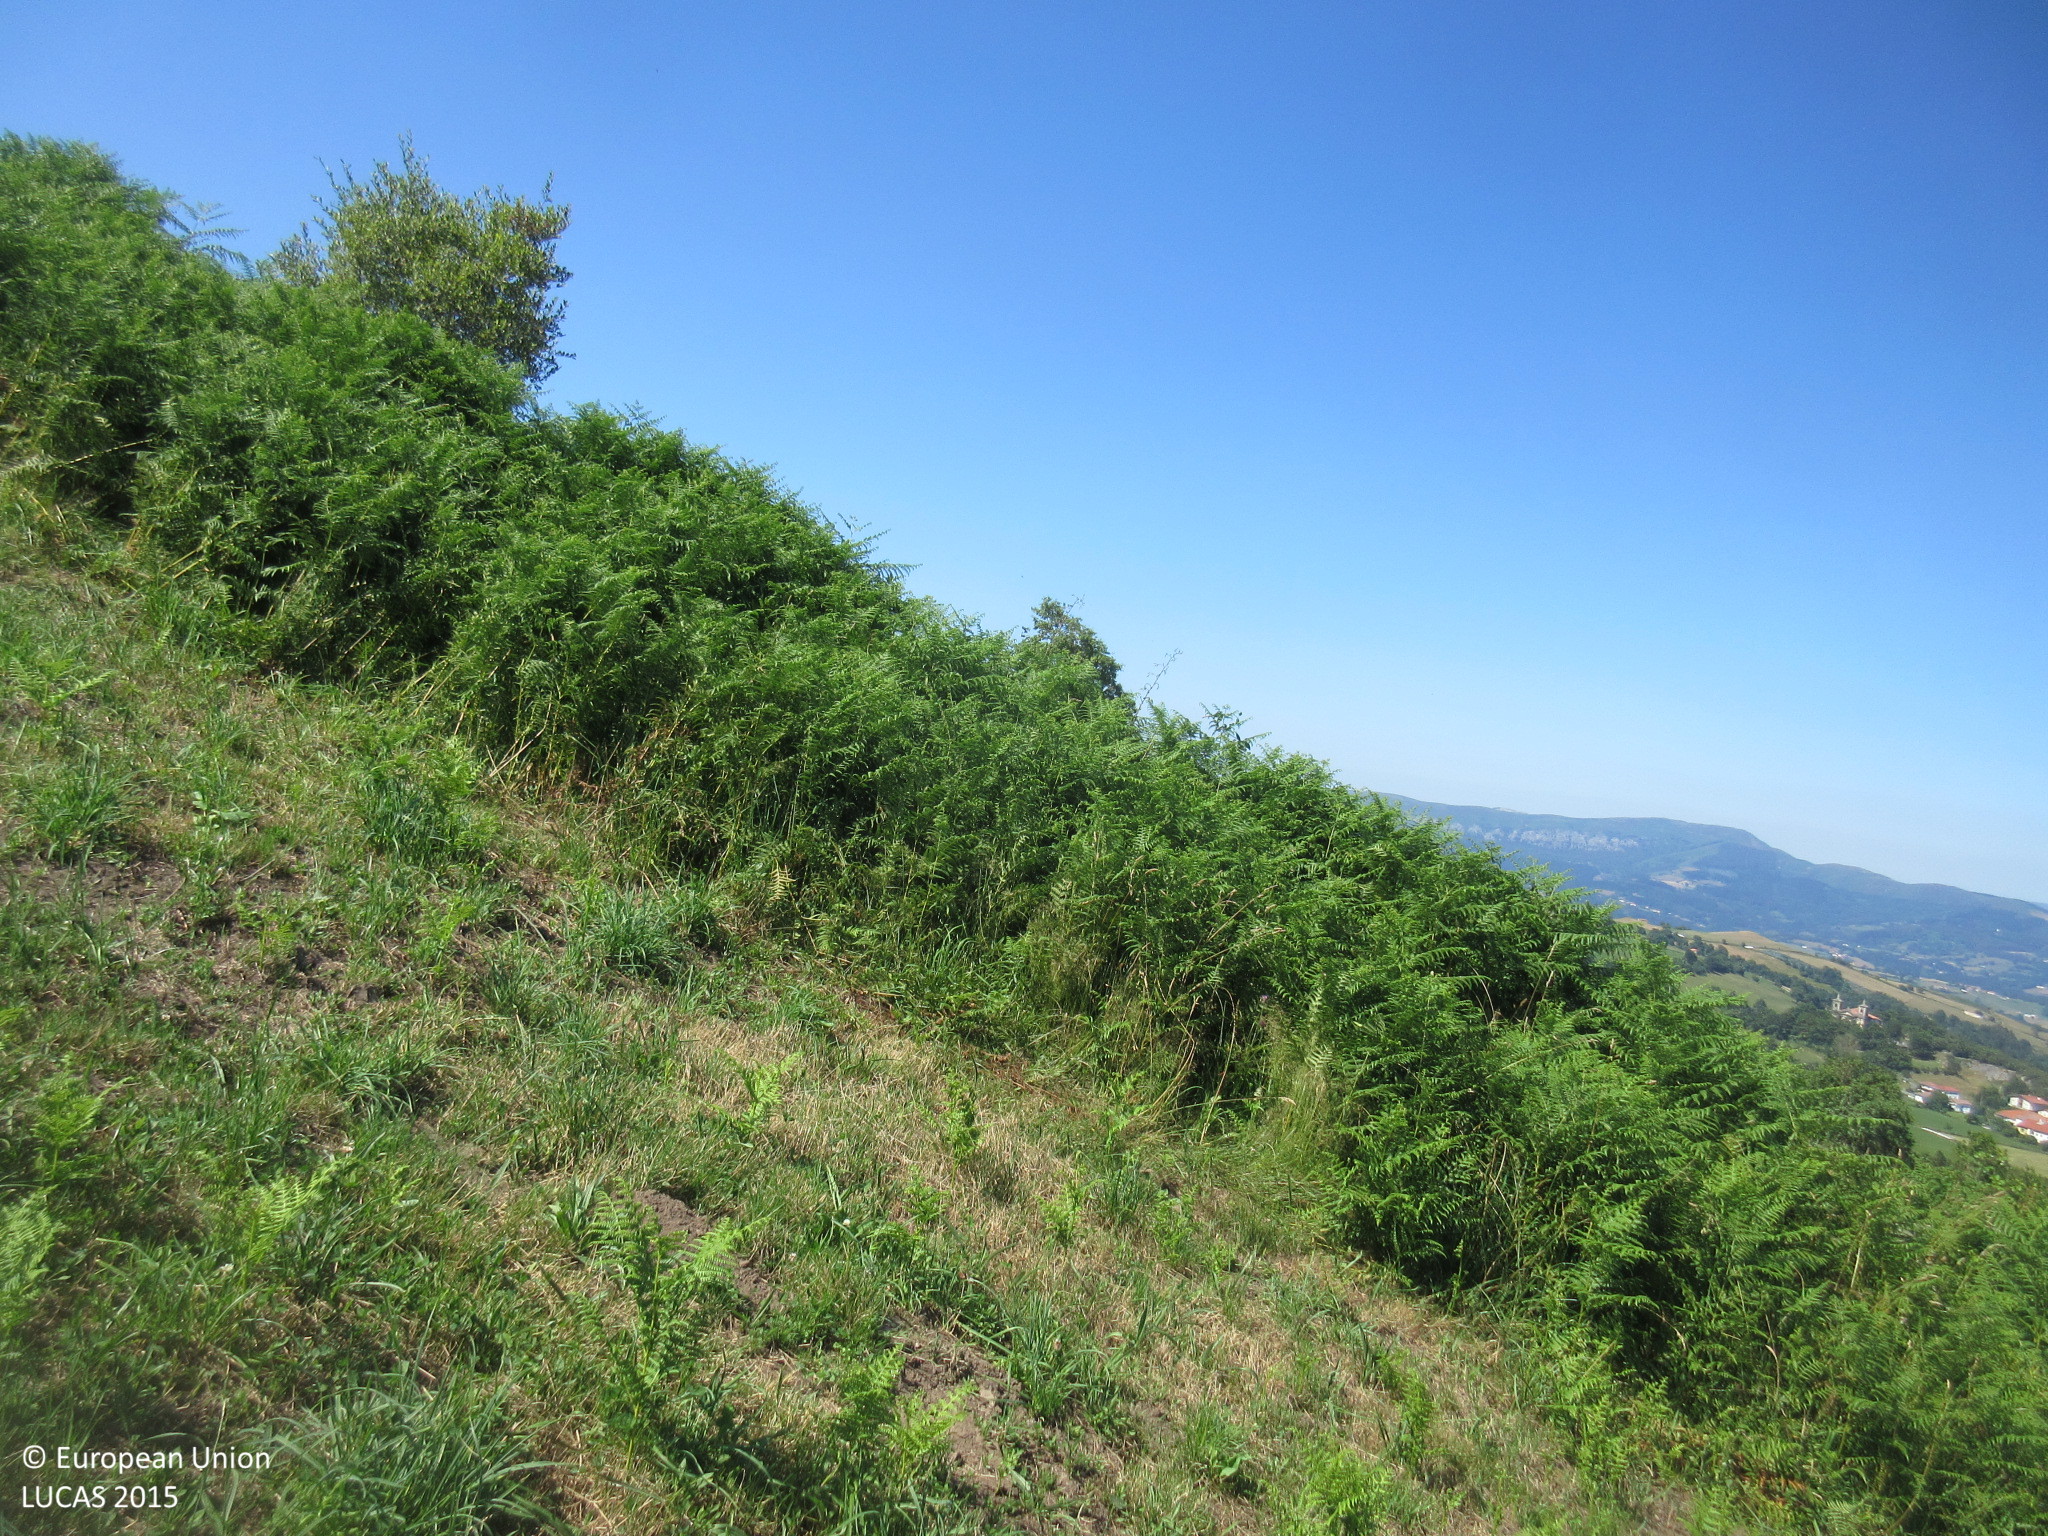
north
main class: Grassland
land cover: Grassland without tree/shrub cover
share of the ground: > 75 %
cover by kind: herbaceous plants 100 %
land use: Agriculture (excluding fallow land and kitchen gardens)
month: July
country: ES
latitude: 43.1860
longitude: -3.3898
